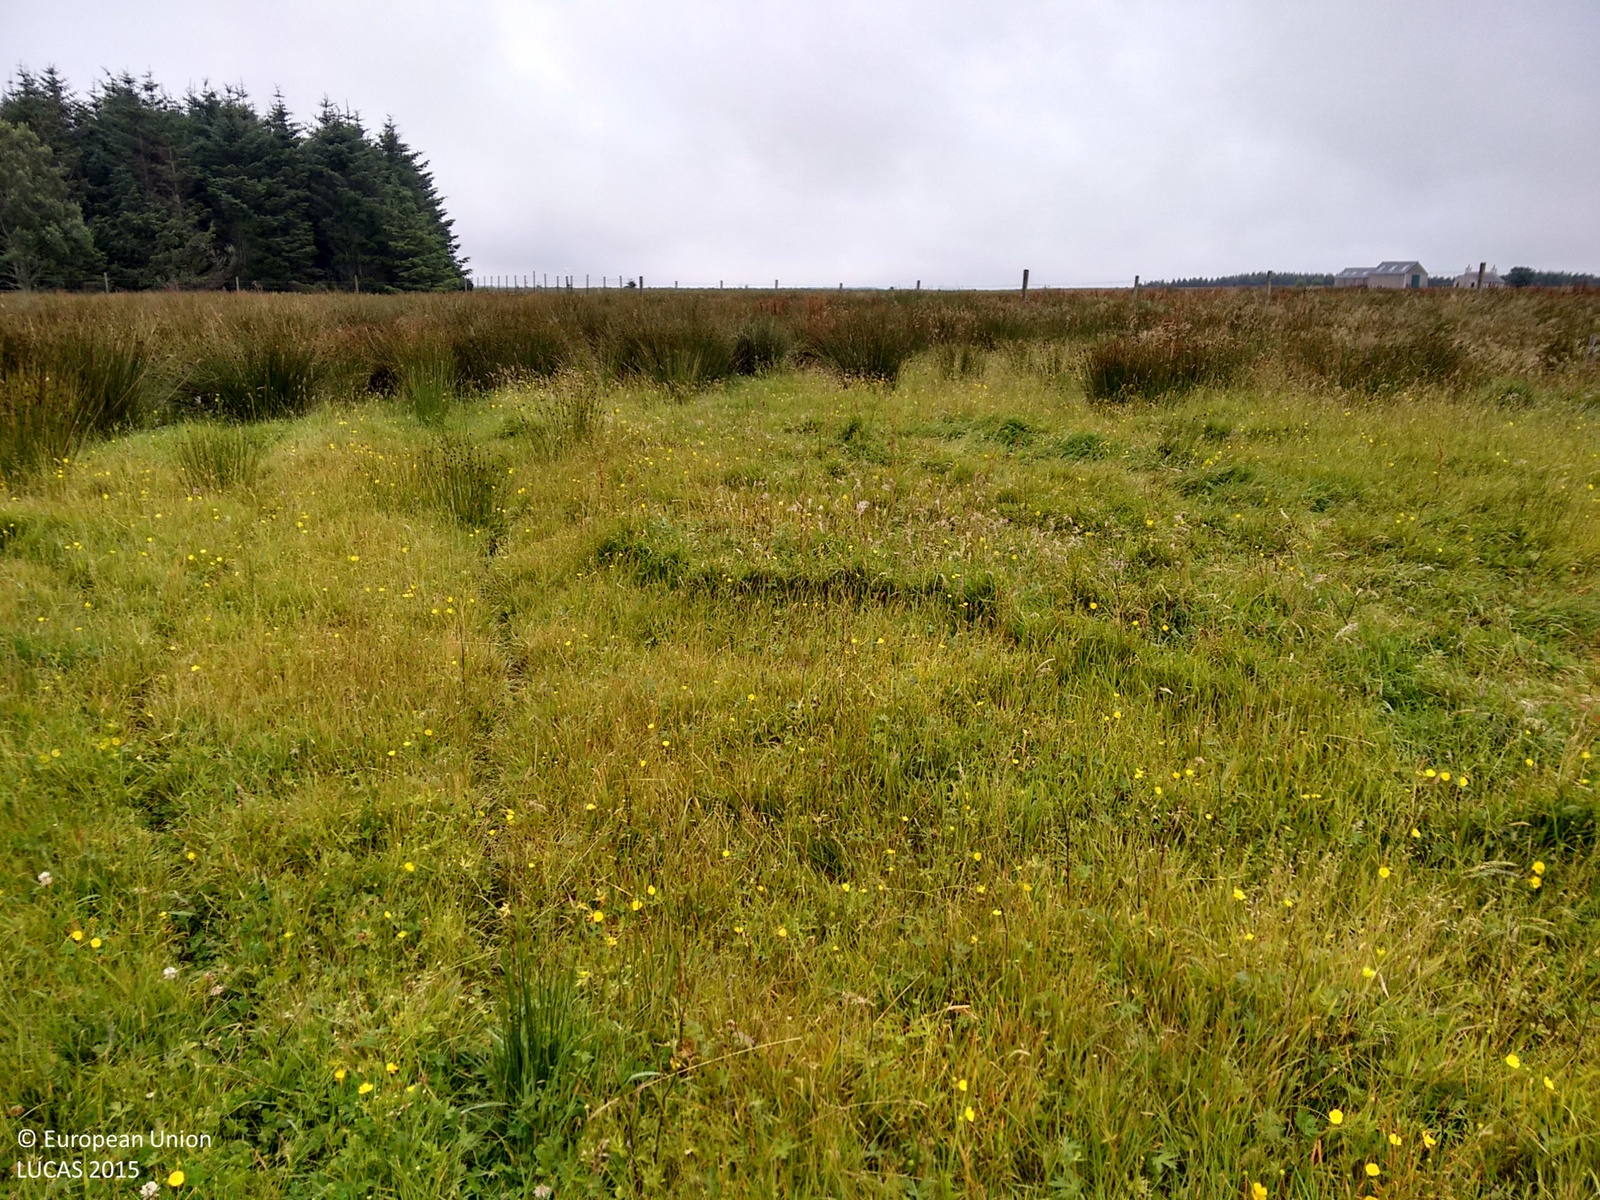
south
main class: Grassland
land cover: Grassland without tree/shrub cover
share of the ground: > 75 %
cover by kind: herbaceous plants 100 %
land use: Agriculture (excluding fallow land and kitchen gardens)
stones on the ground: < 10 %
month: August
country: GB
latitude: 58.4306
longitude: -3.1249
